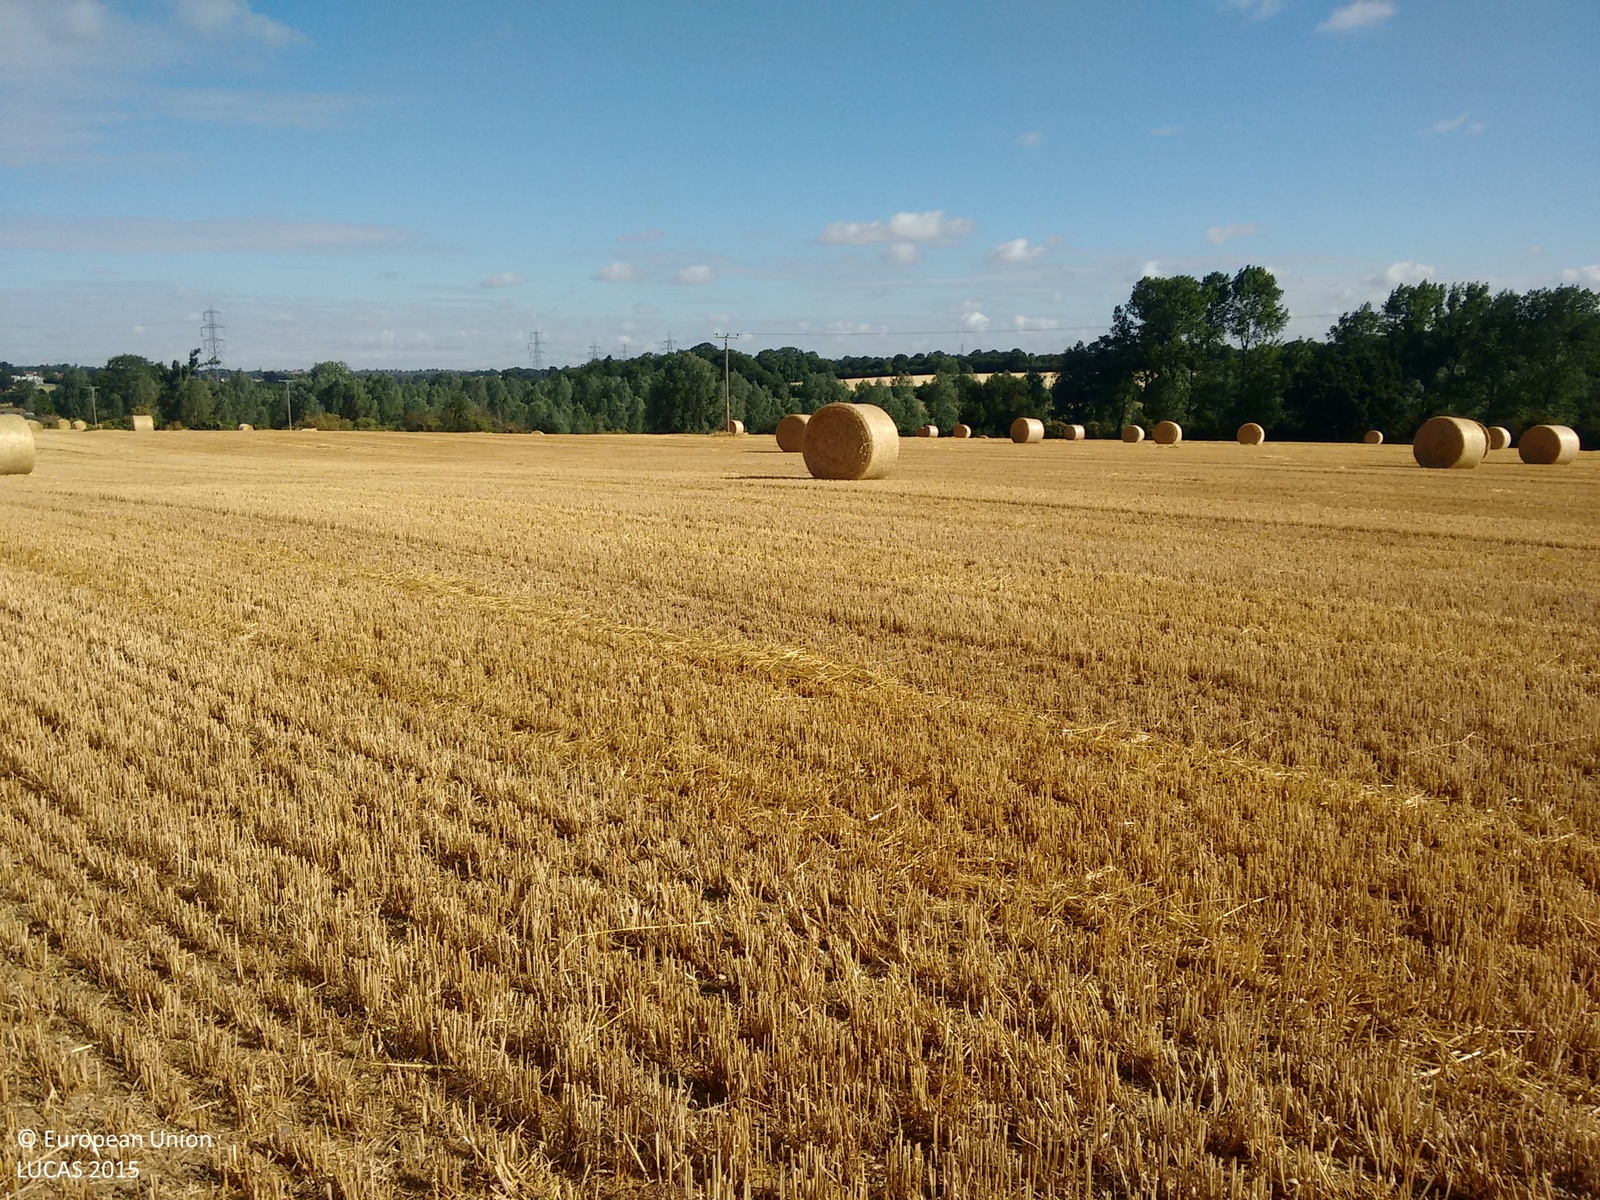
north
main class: Cropland
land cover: Barley
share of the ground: > 75 %
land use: Agriculture (excluding fallow land and kitchen gardens)
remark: Harvested field
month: July
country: GB
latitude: 51.8394
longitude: 0.5825
